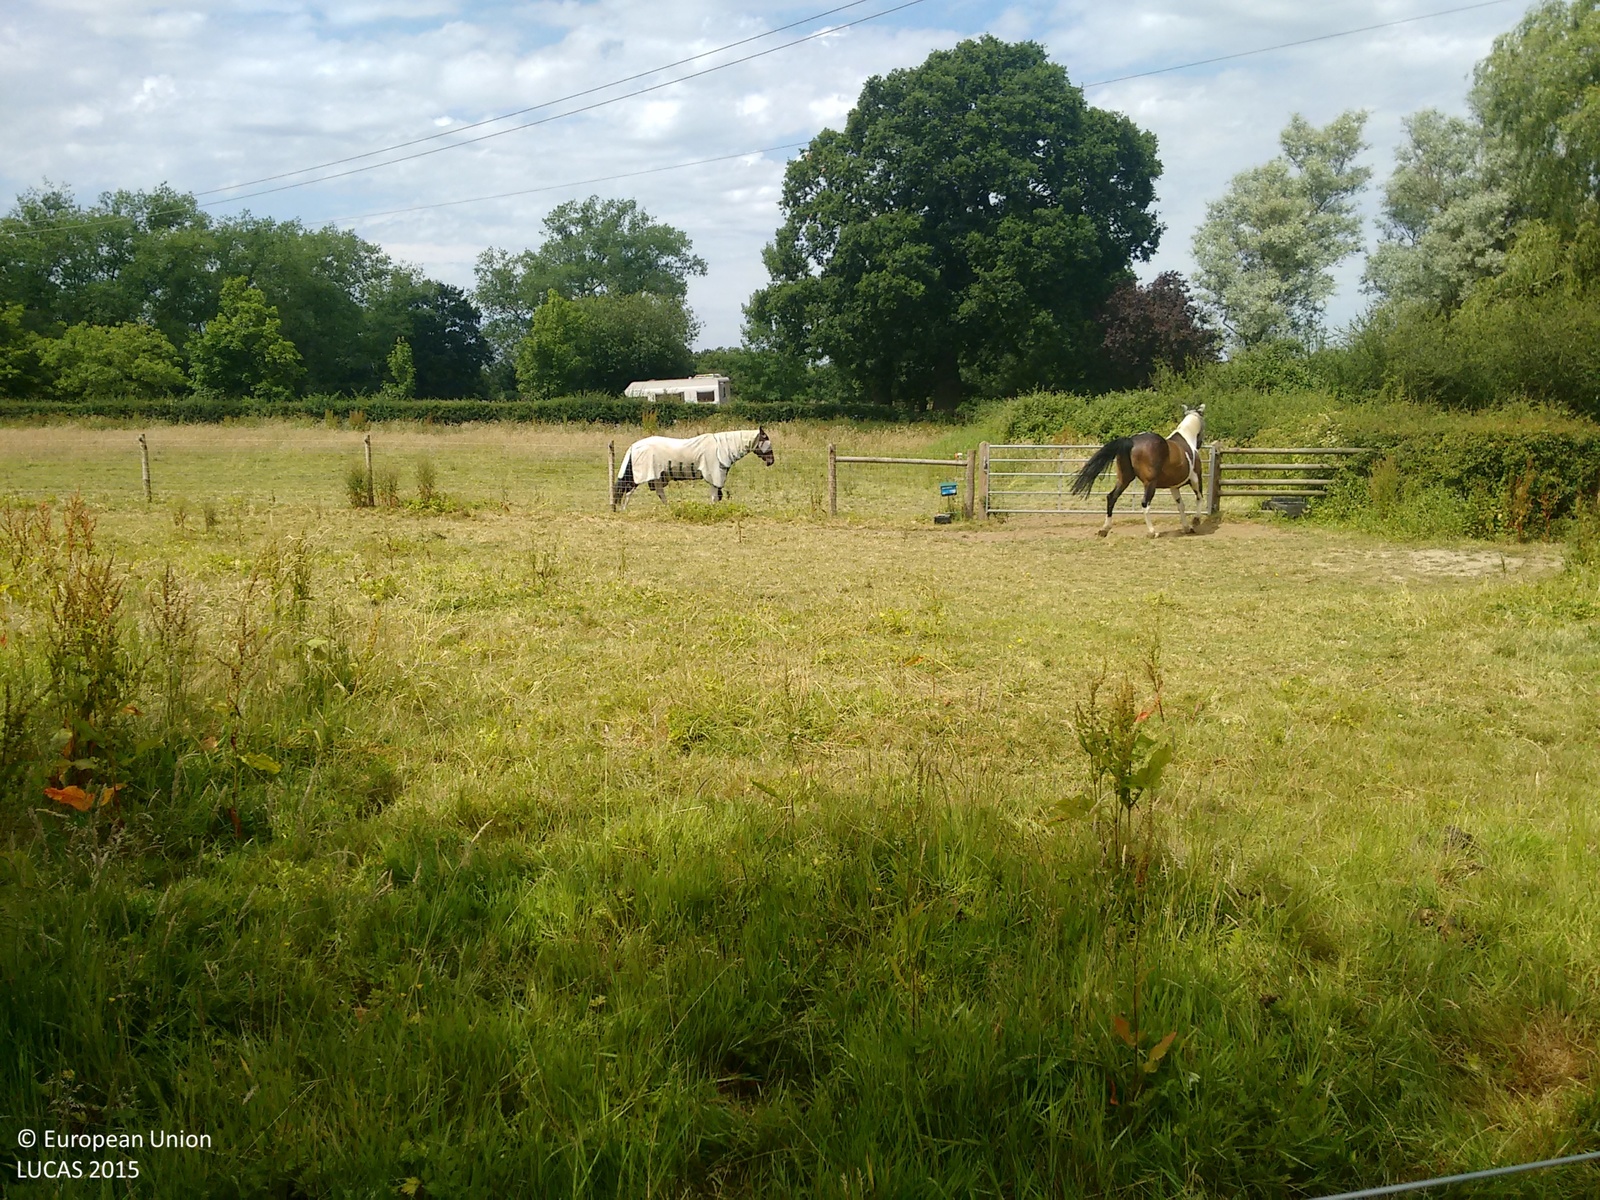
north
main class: Grassland
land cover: Grassland without tree/shrub cover
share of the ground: > 75 %
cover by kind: herbaceous plants 100 %
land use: Agriculture (excluding fallow land and kitchen gardens)
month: July
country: GB
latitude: 50.9569
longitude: -0.2142
